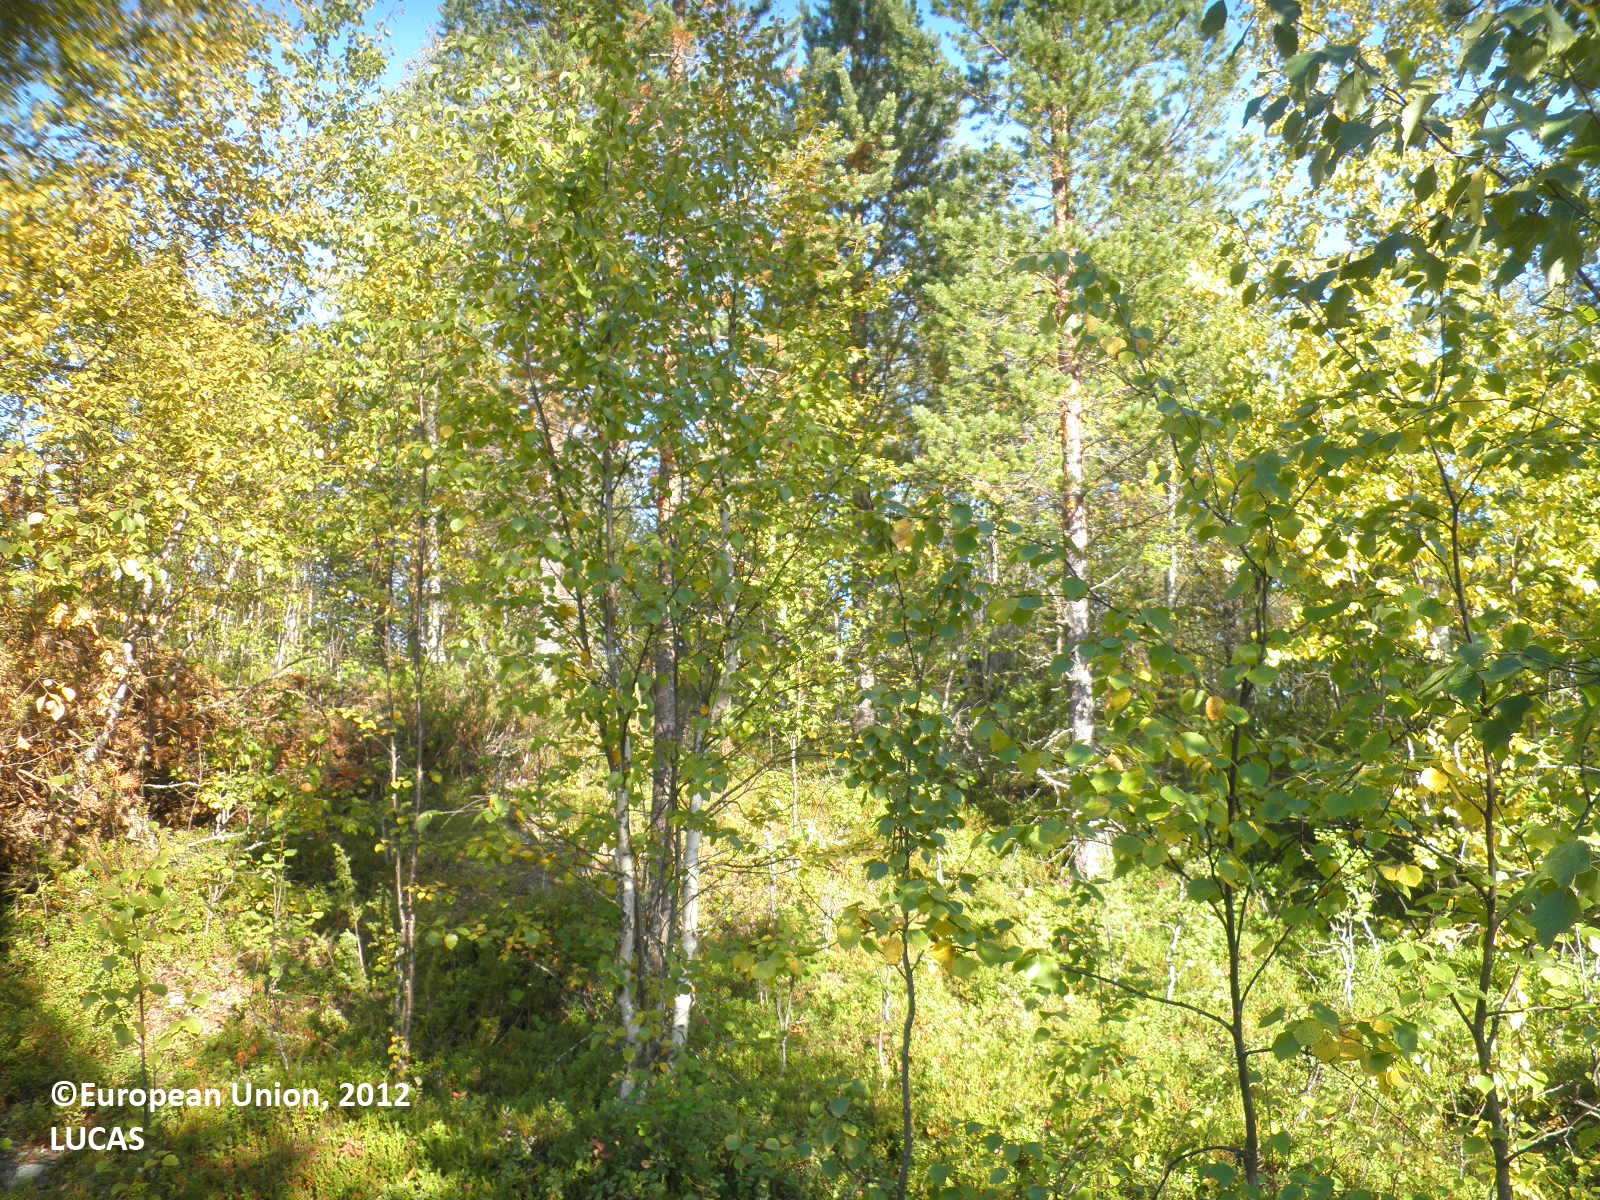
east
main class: Woodland
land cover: Pine dominated mixed woodland
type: boreal forest
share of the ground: 50 - 75 %
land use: Forestry
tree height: > 5 m
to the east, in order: Pine dominated mixed woodland; Peatbogs; Ditches and canals; Broadleaved woodland; Ditches and canals; Pine dominated mixed woodland
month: August
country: FI
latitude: 67.6957
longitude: 27.2041
